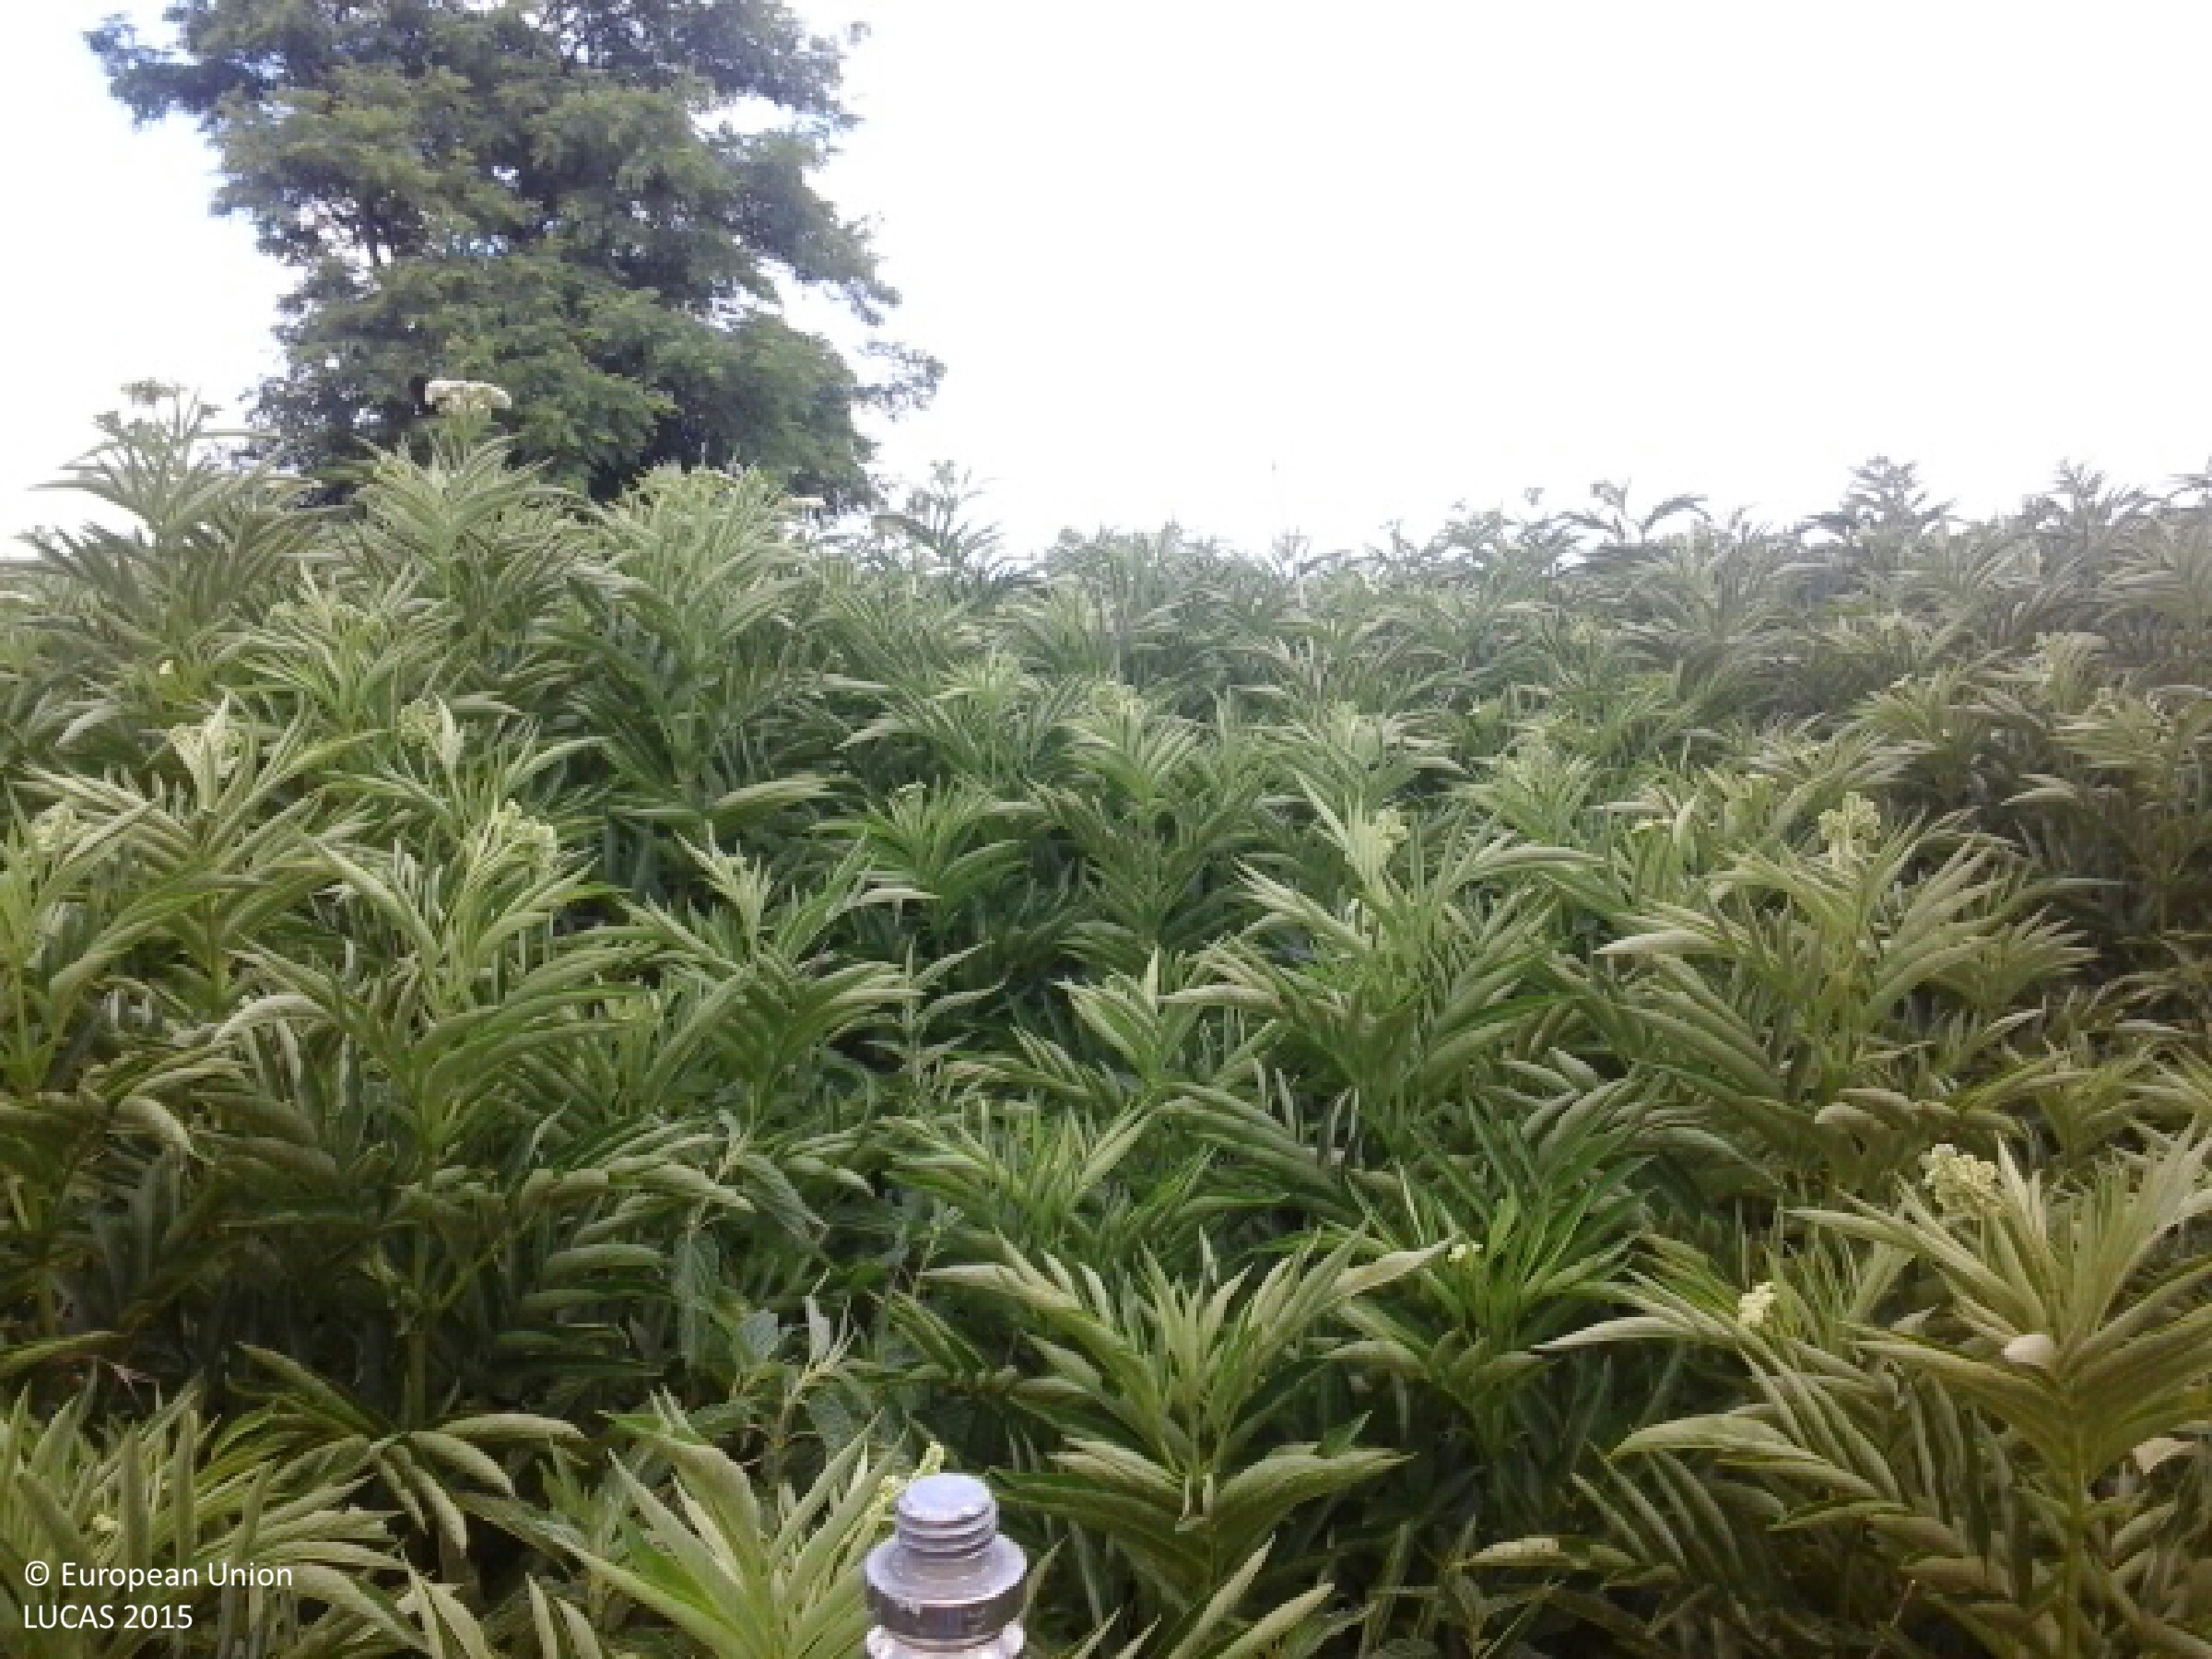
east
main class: Grassland
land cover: Spontaneously vegetated surfaces
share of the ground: > 75 %
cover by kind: herbaceous plants 95 %, shrubs 5 %
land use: Semi-natural and natural areas not in use
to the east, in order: Spontaneously vegetated surfaces; Abandoned hedges; Tracks; Grass margins; Maize
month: June
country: HU
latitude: 48.0697
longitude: 21.7108
